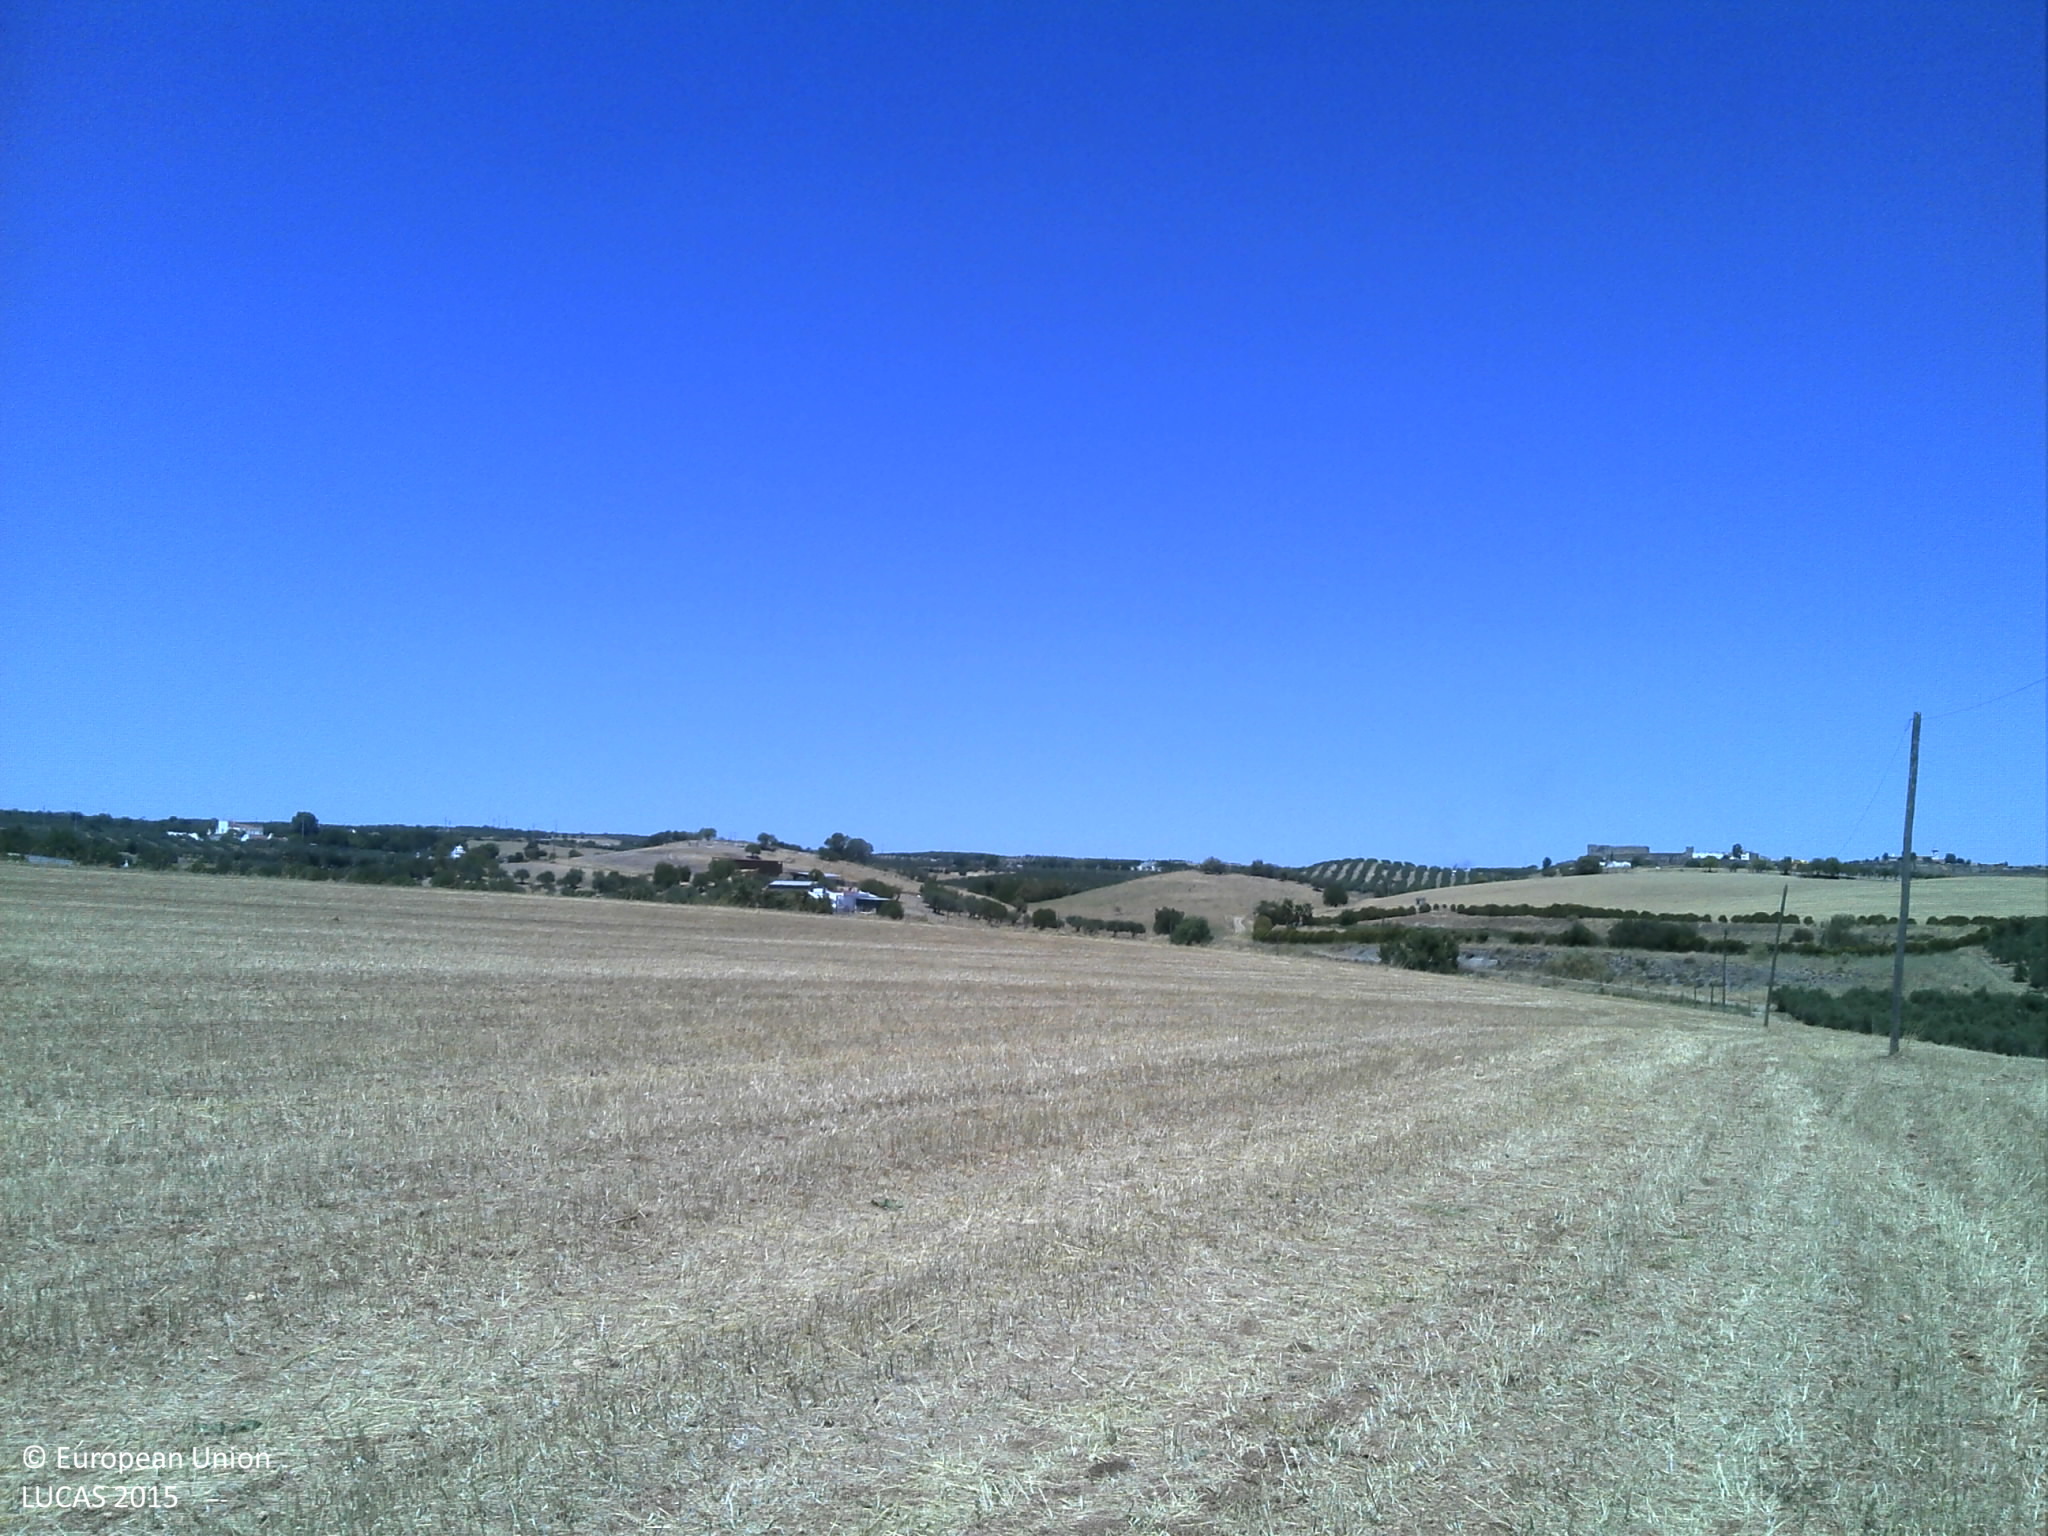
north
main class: Cropland
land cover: Oats
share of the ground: 10 - 25 %
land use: Agriculture (excluding fallow land and kitchen gardens)
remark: Harvested field
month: July
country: PT
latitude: 38.9965
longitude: -7.0819
